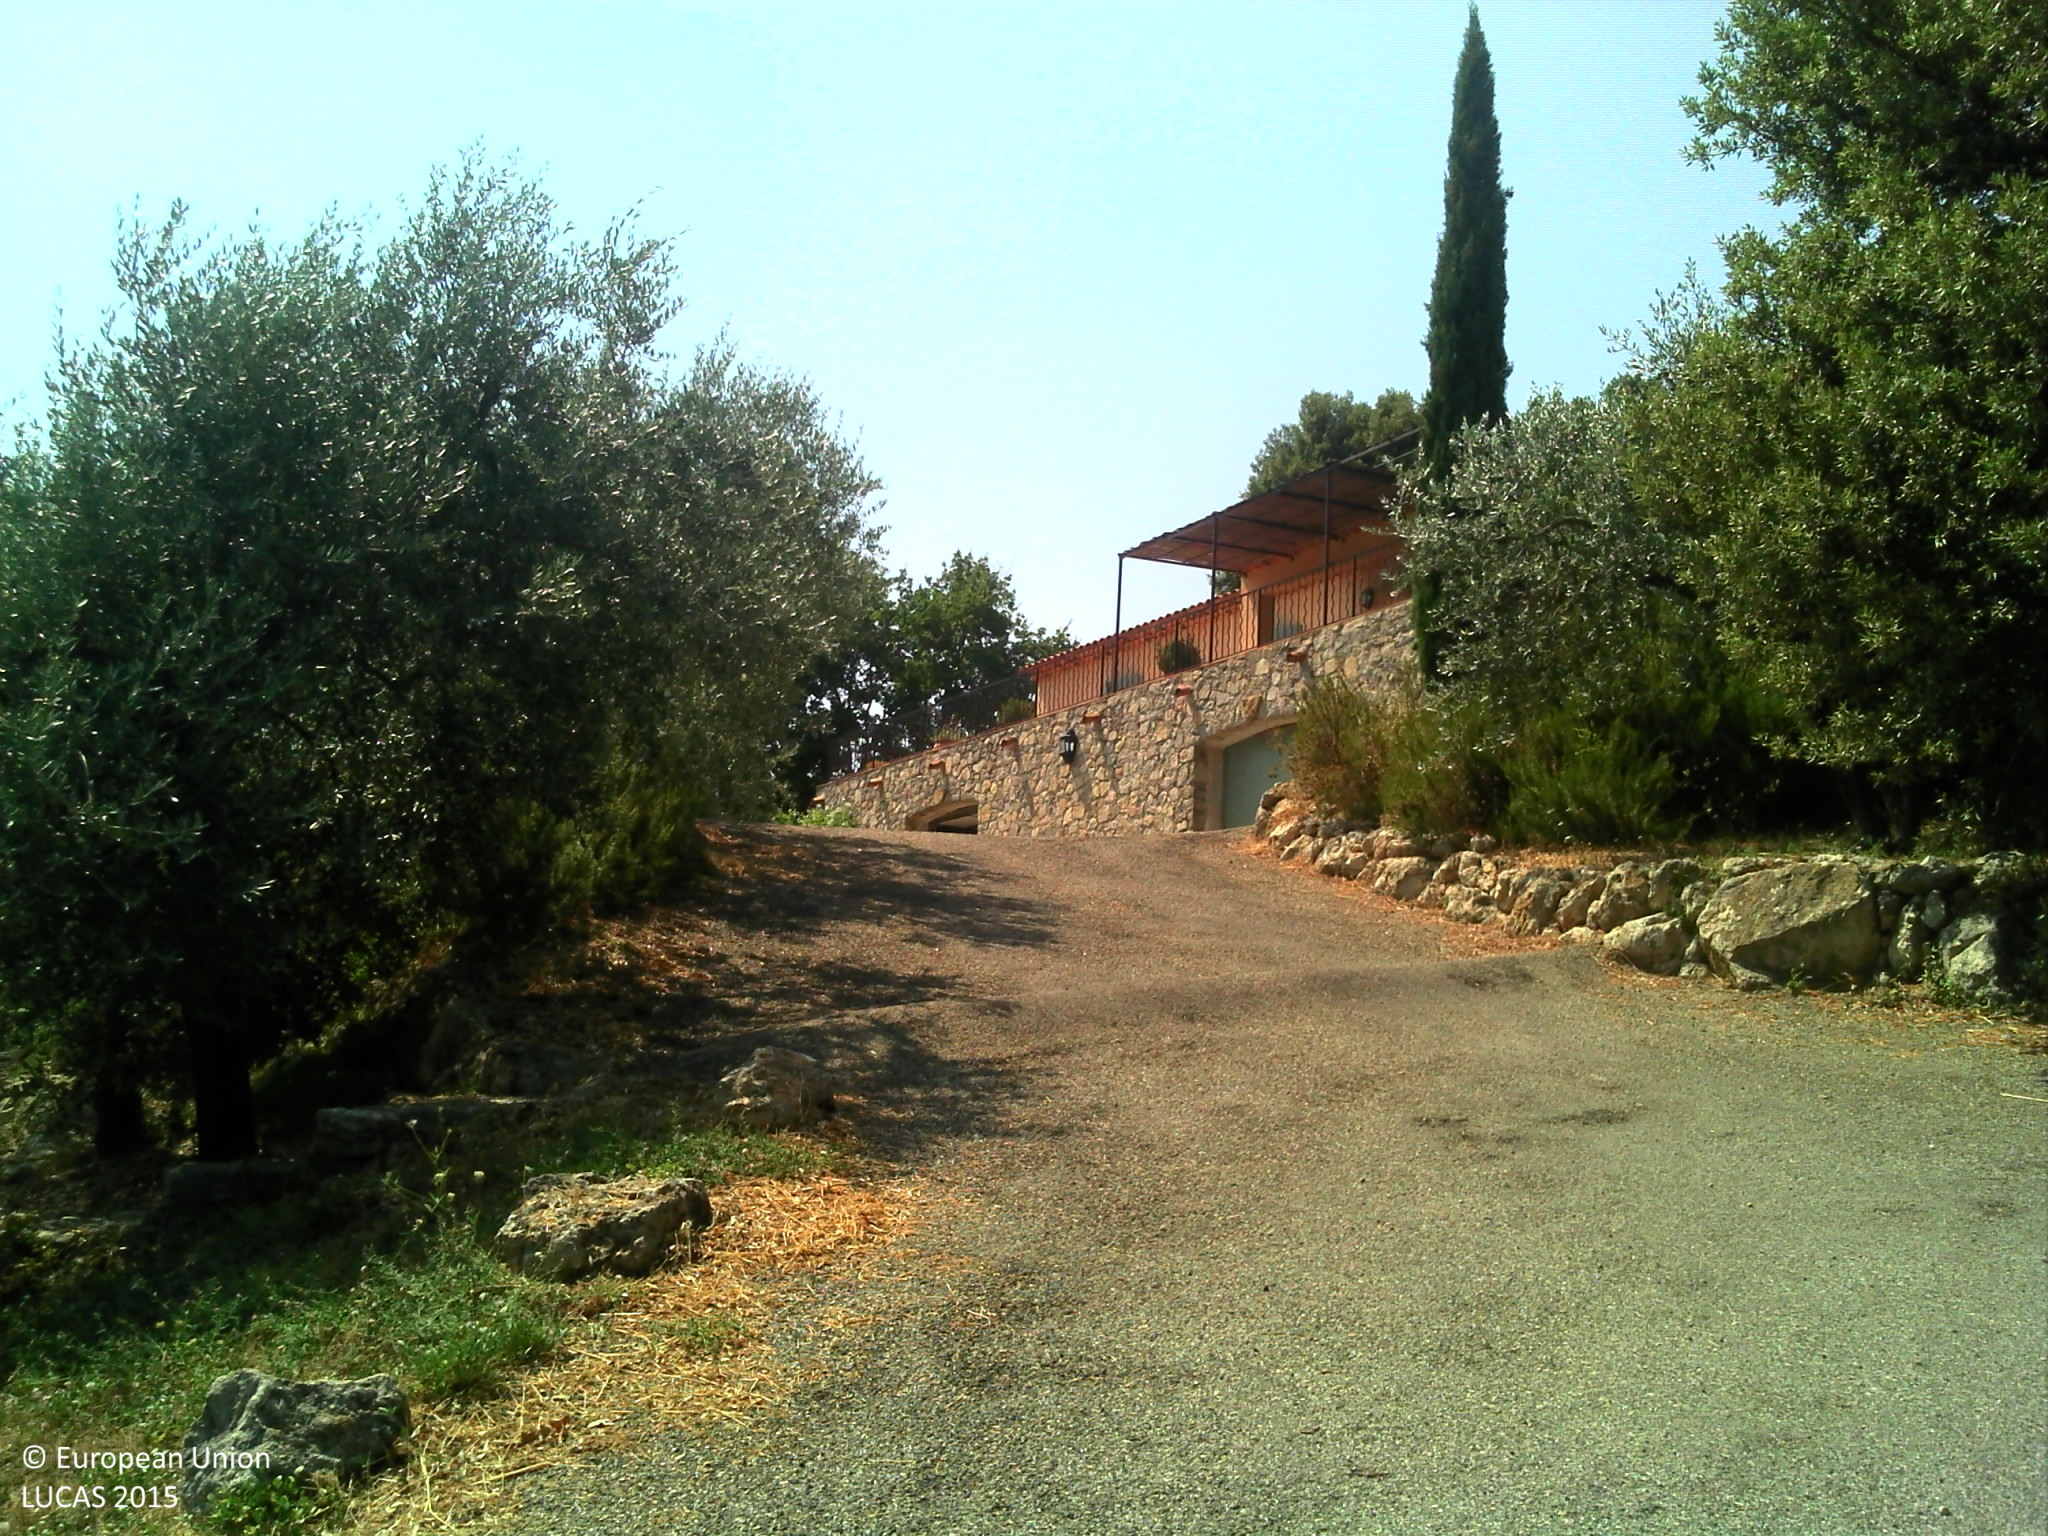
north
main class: Grassland
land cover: Grassland with sparse tree/shrub cover
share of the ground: > 75 %
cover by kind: herbaceous plants 85 %, shrubs 10 %, coniferous forest trees 5 %
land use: Residential
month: August
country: FR
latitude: 43.5694
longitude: 6.5043
